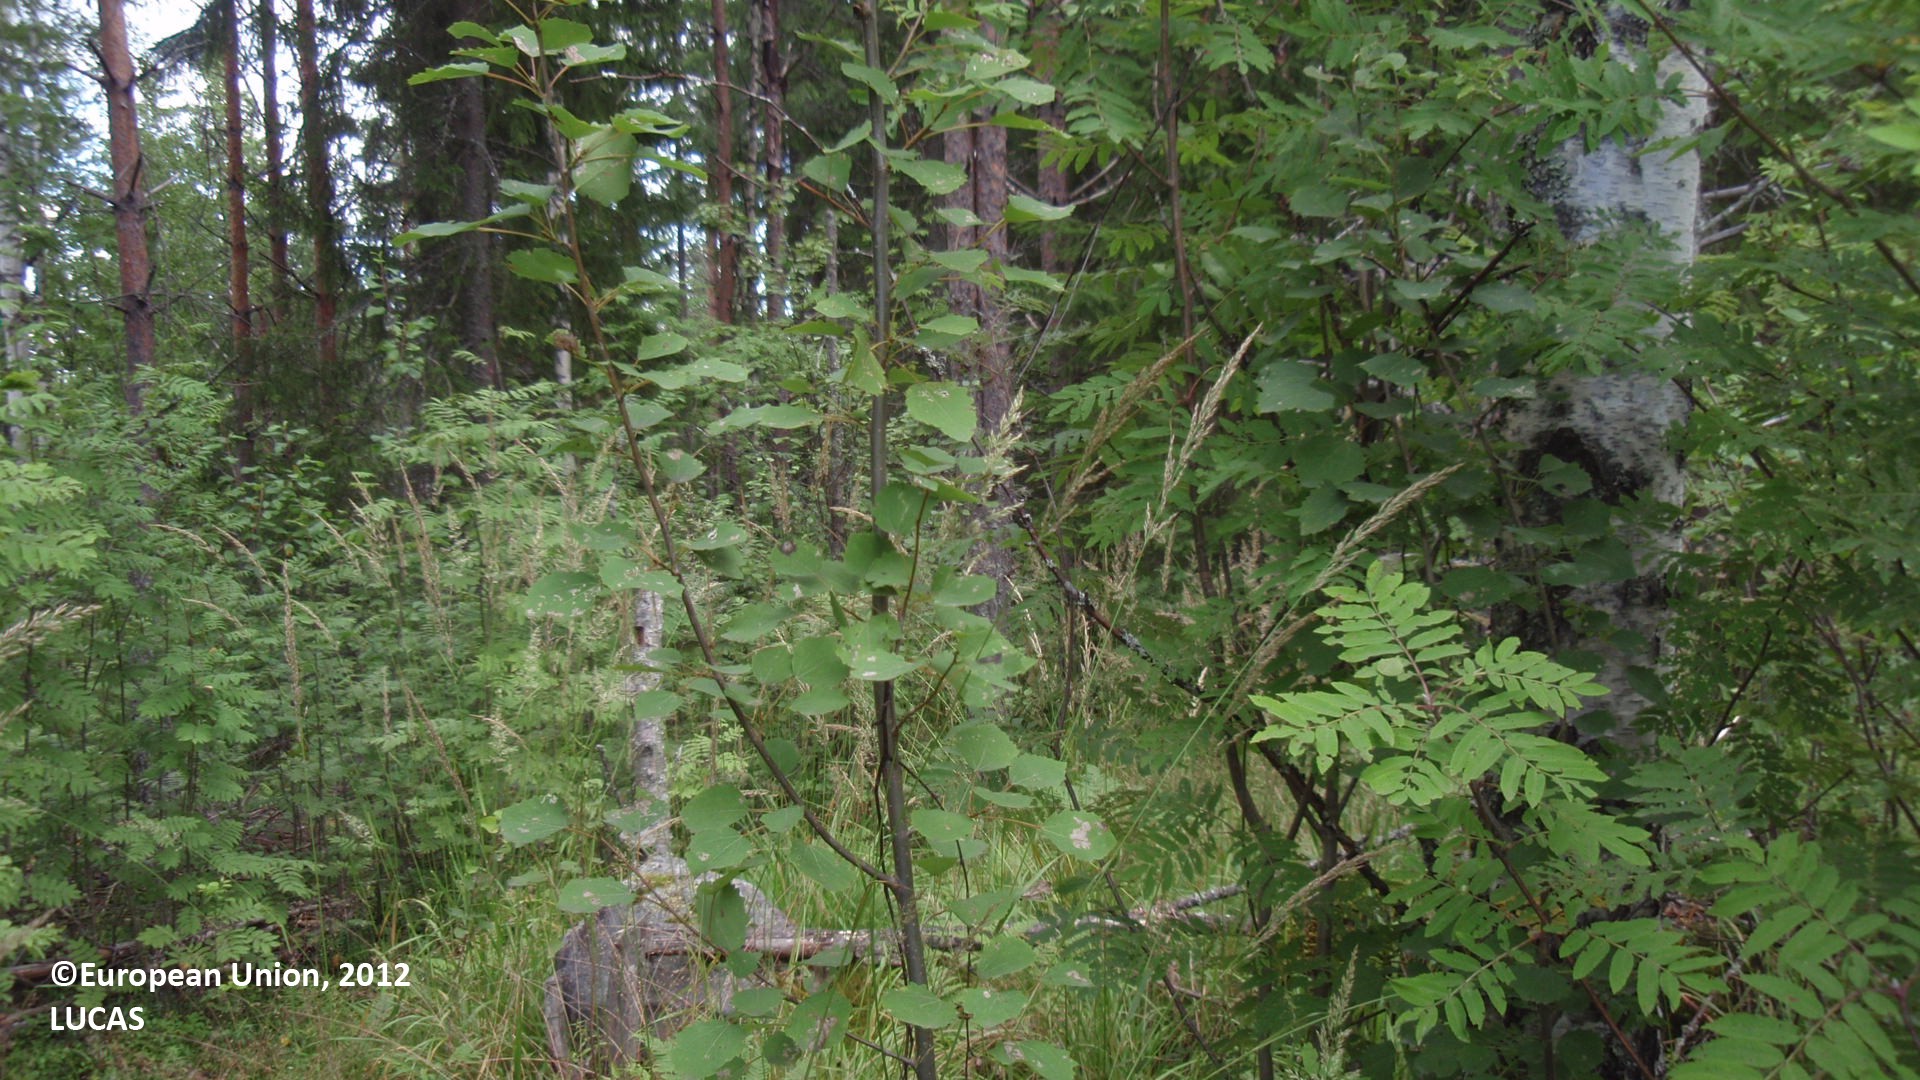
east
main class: Woodland
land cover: Spruce dominated mixed woodland
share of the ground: 50 - 75 %
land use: Forestry
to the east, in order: Spruce dominated mixed woodland; Pine dominated mixed woodland; Spruce dominated mixed woodland; Pine dominated mixed woodland; Pine dominated coniferous woodland
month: July
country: FI
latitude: 61.3796
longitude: 28.8858
